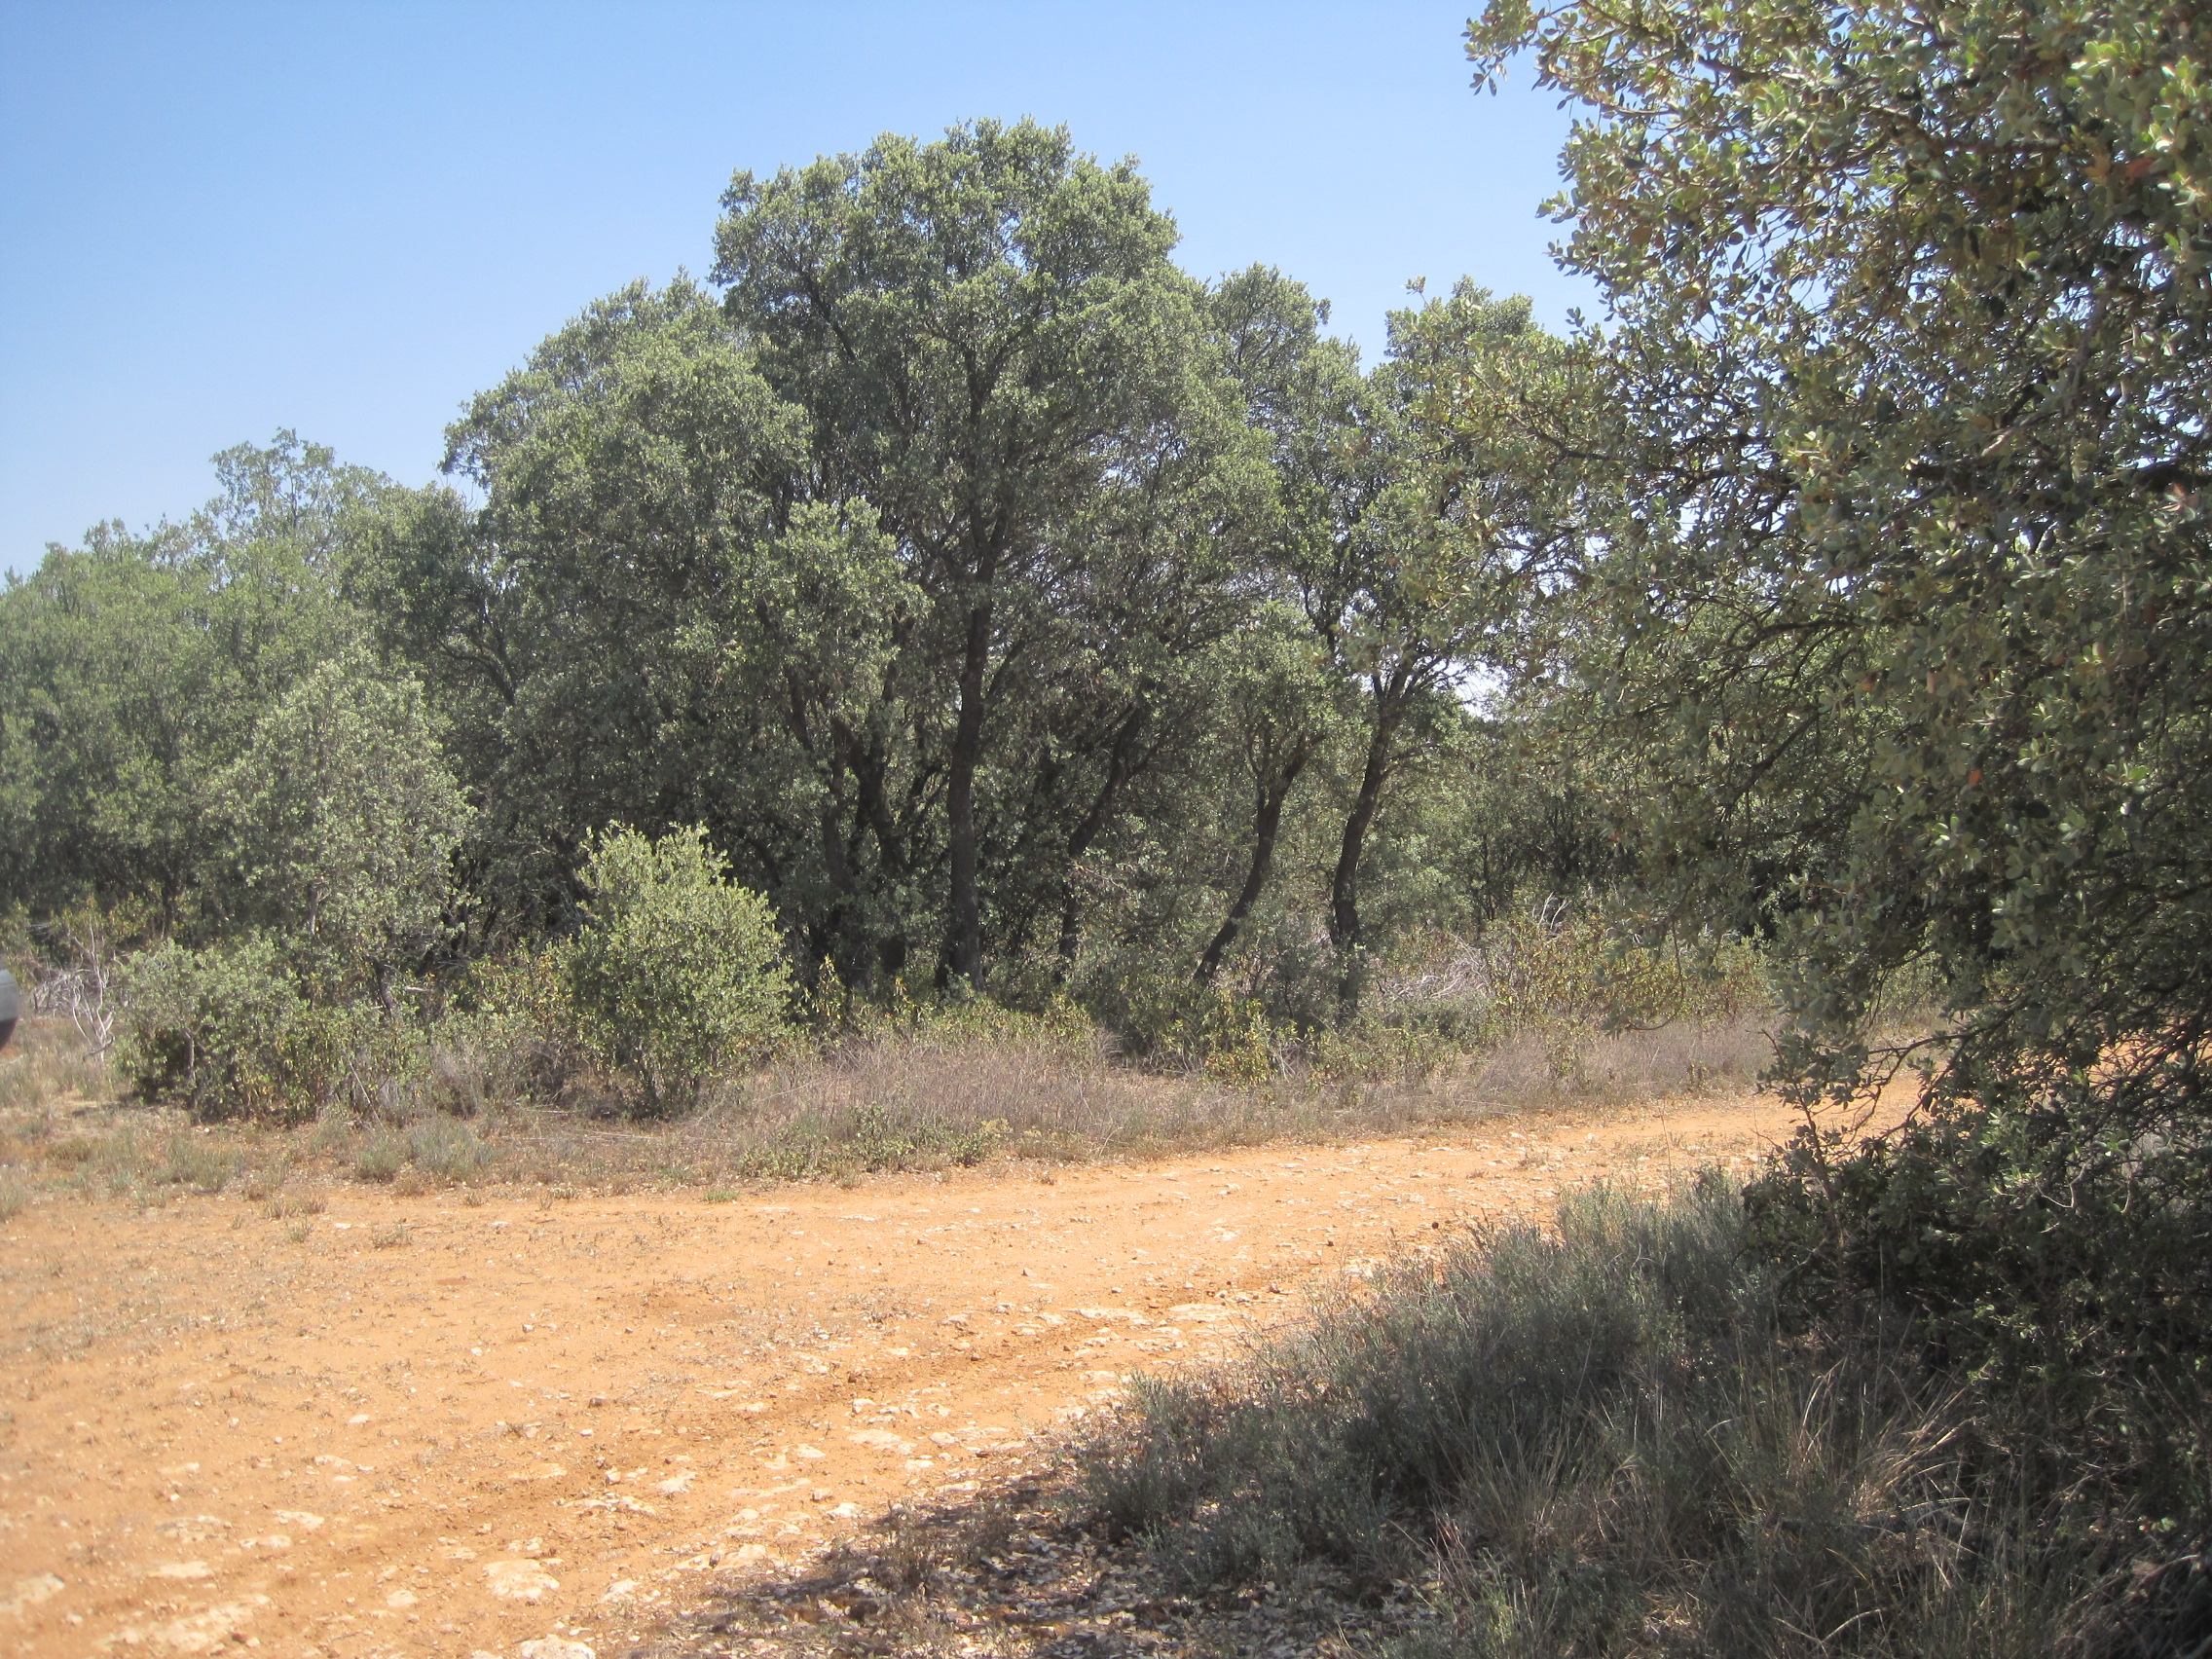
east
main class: Woodland
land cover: Broadleaved woodland
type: thermophilous deciduous forest
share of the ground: > 75 %
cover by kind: broadleaved forest trees 80 %, herbaceous plants 20 %
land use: Forestry
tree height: > 5 m
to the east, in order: Broadleaved woodland; Tracks; Broadleaved woodland; Fences; Tracks; Broadleaved woodland
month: July
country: ES
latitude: 41.7460
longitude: -5.1454
